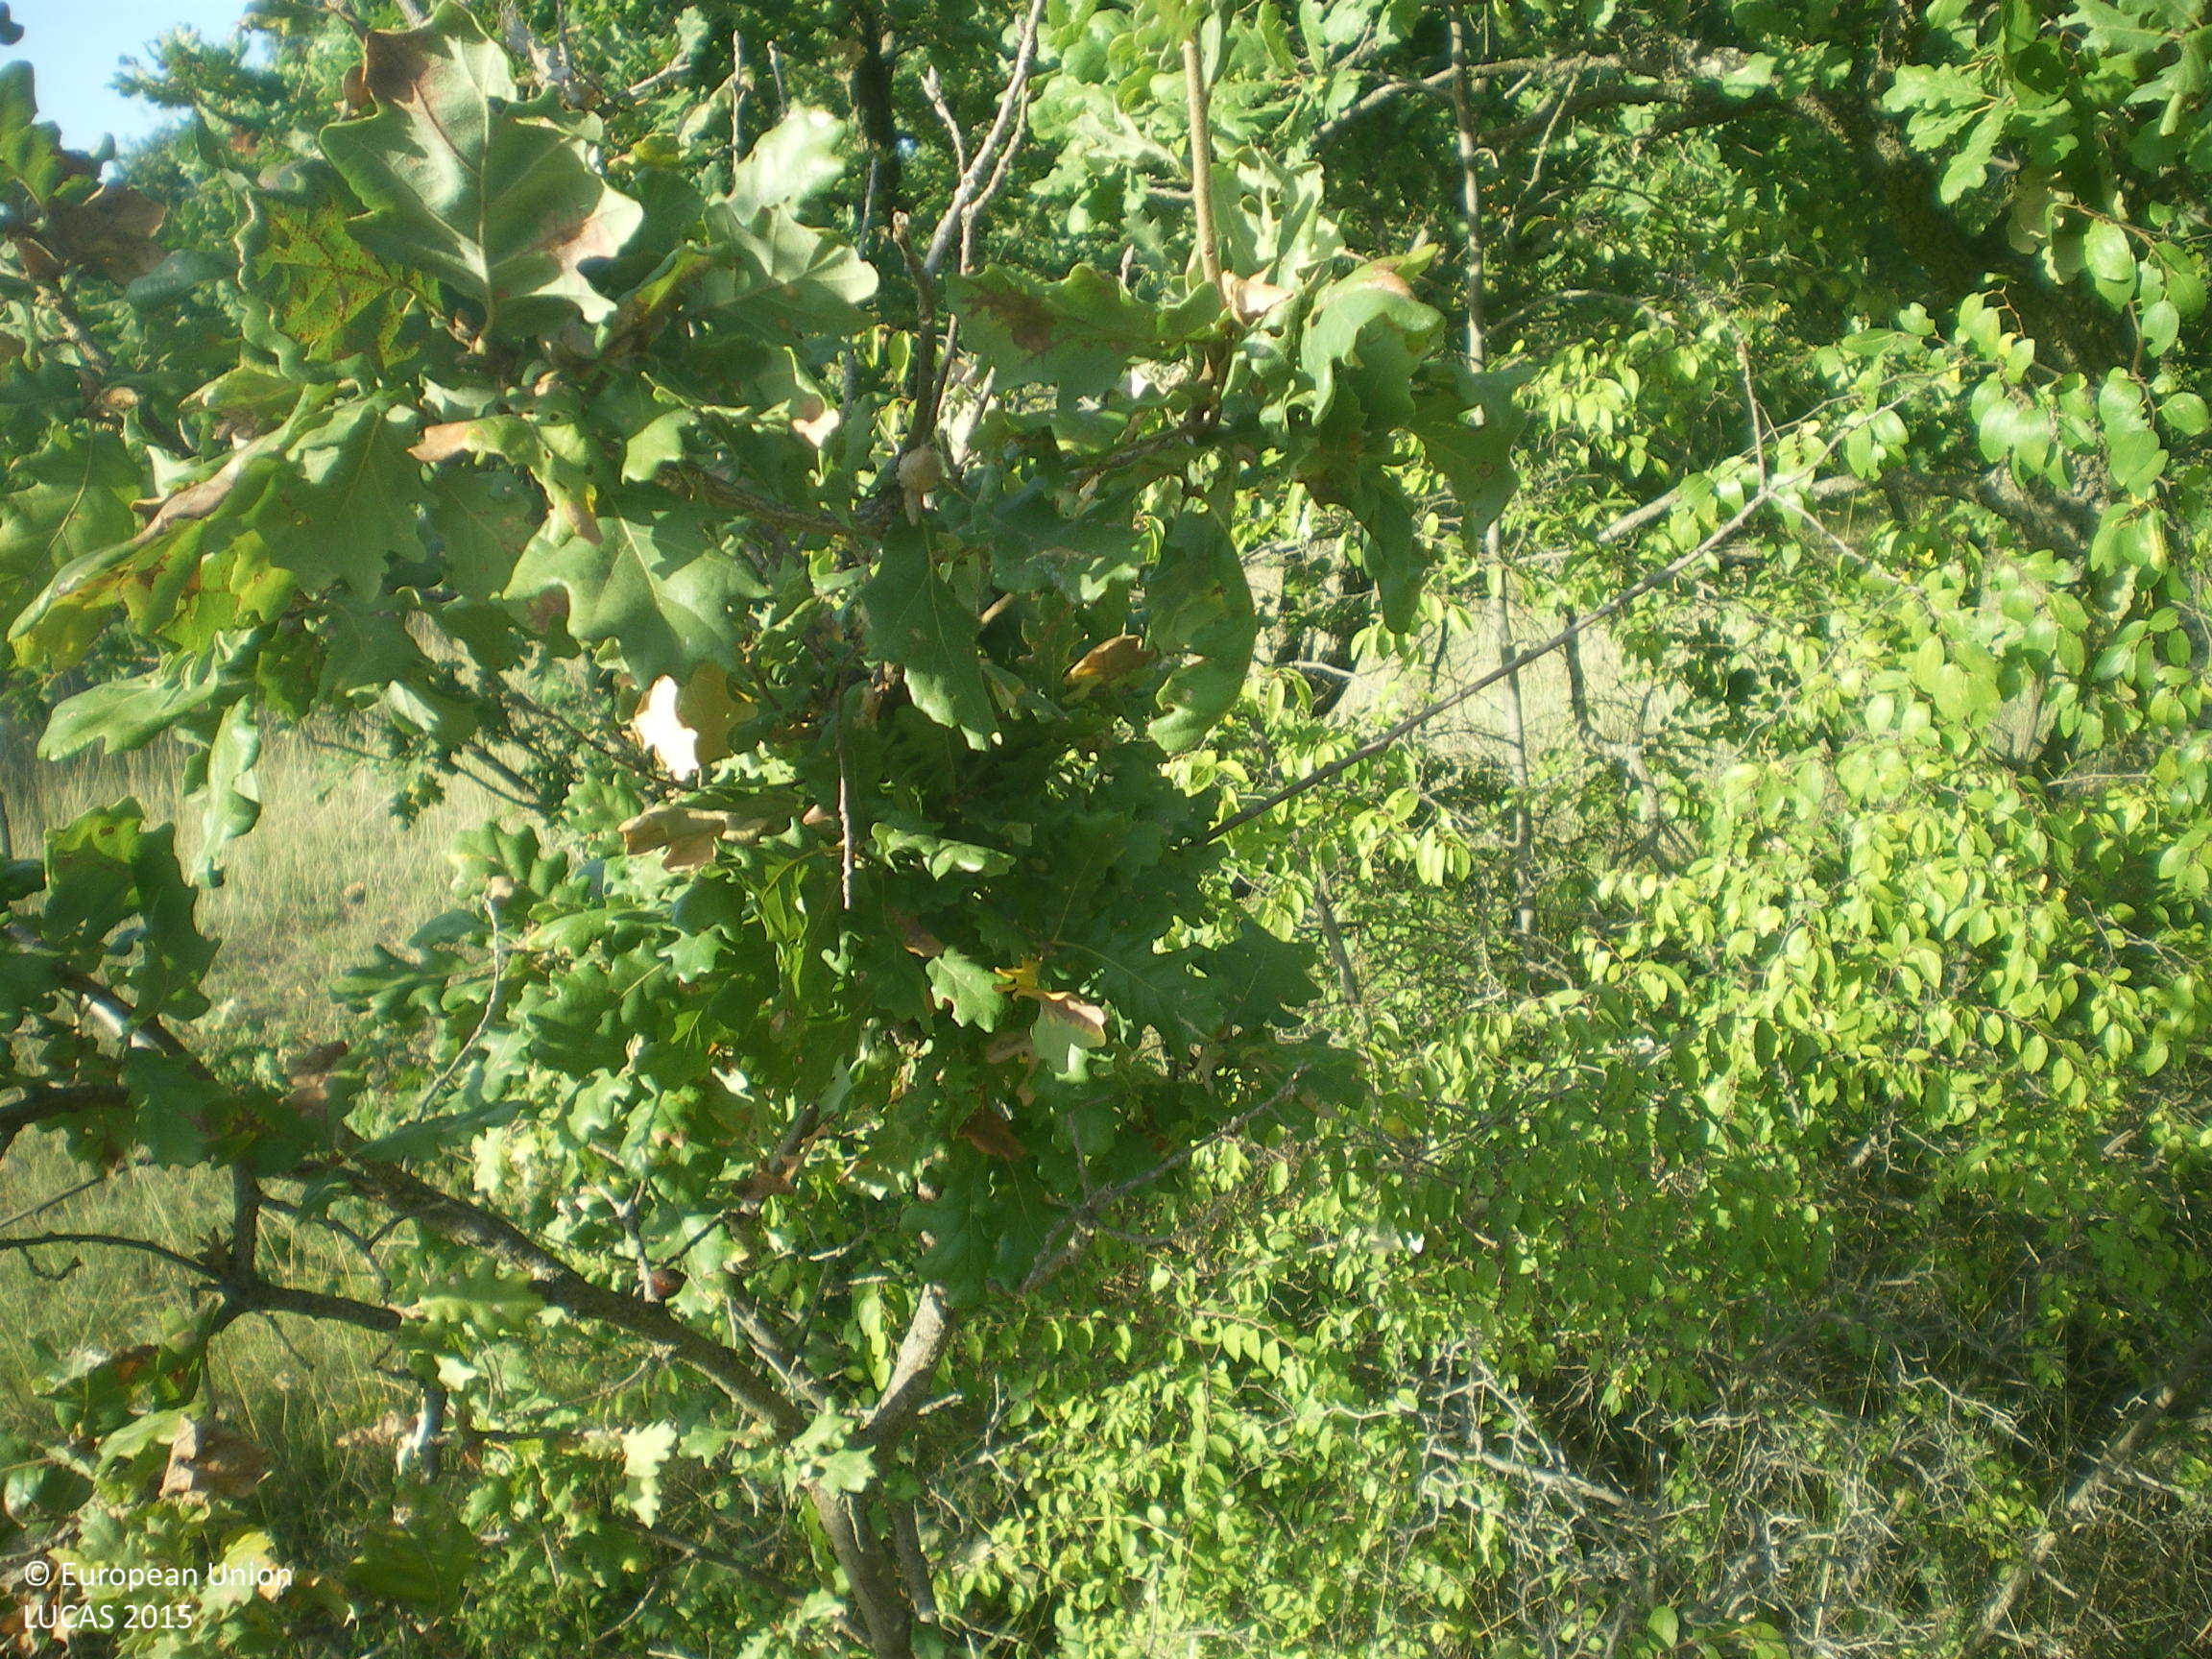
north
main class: Grassland
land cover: Grassland with sparse tree/shrub cover
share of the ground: > 75 %
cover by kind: herbaceous plants 85 %, shrubs 10 %, broadleaved forest trees 5 %
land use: Agriculture (excluding fallow land and kitchen gardens)
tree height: > 5 m
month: September
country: BG
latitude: 41.8051
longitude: 25.8234
